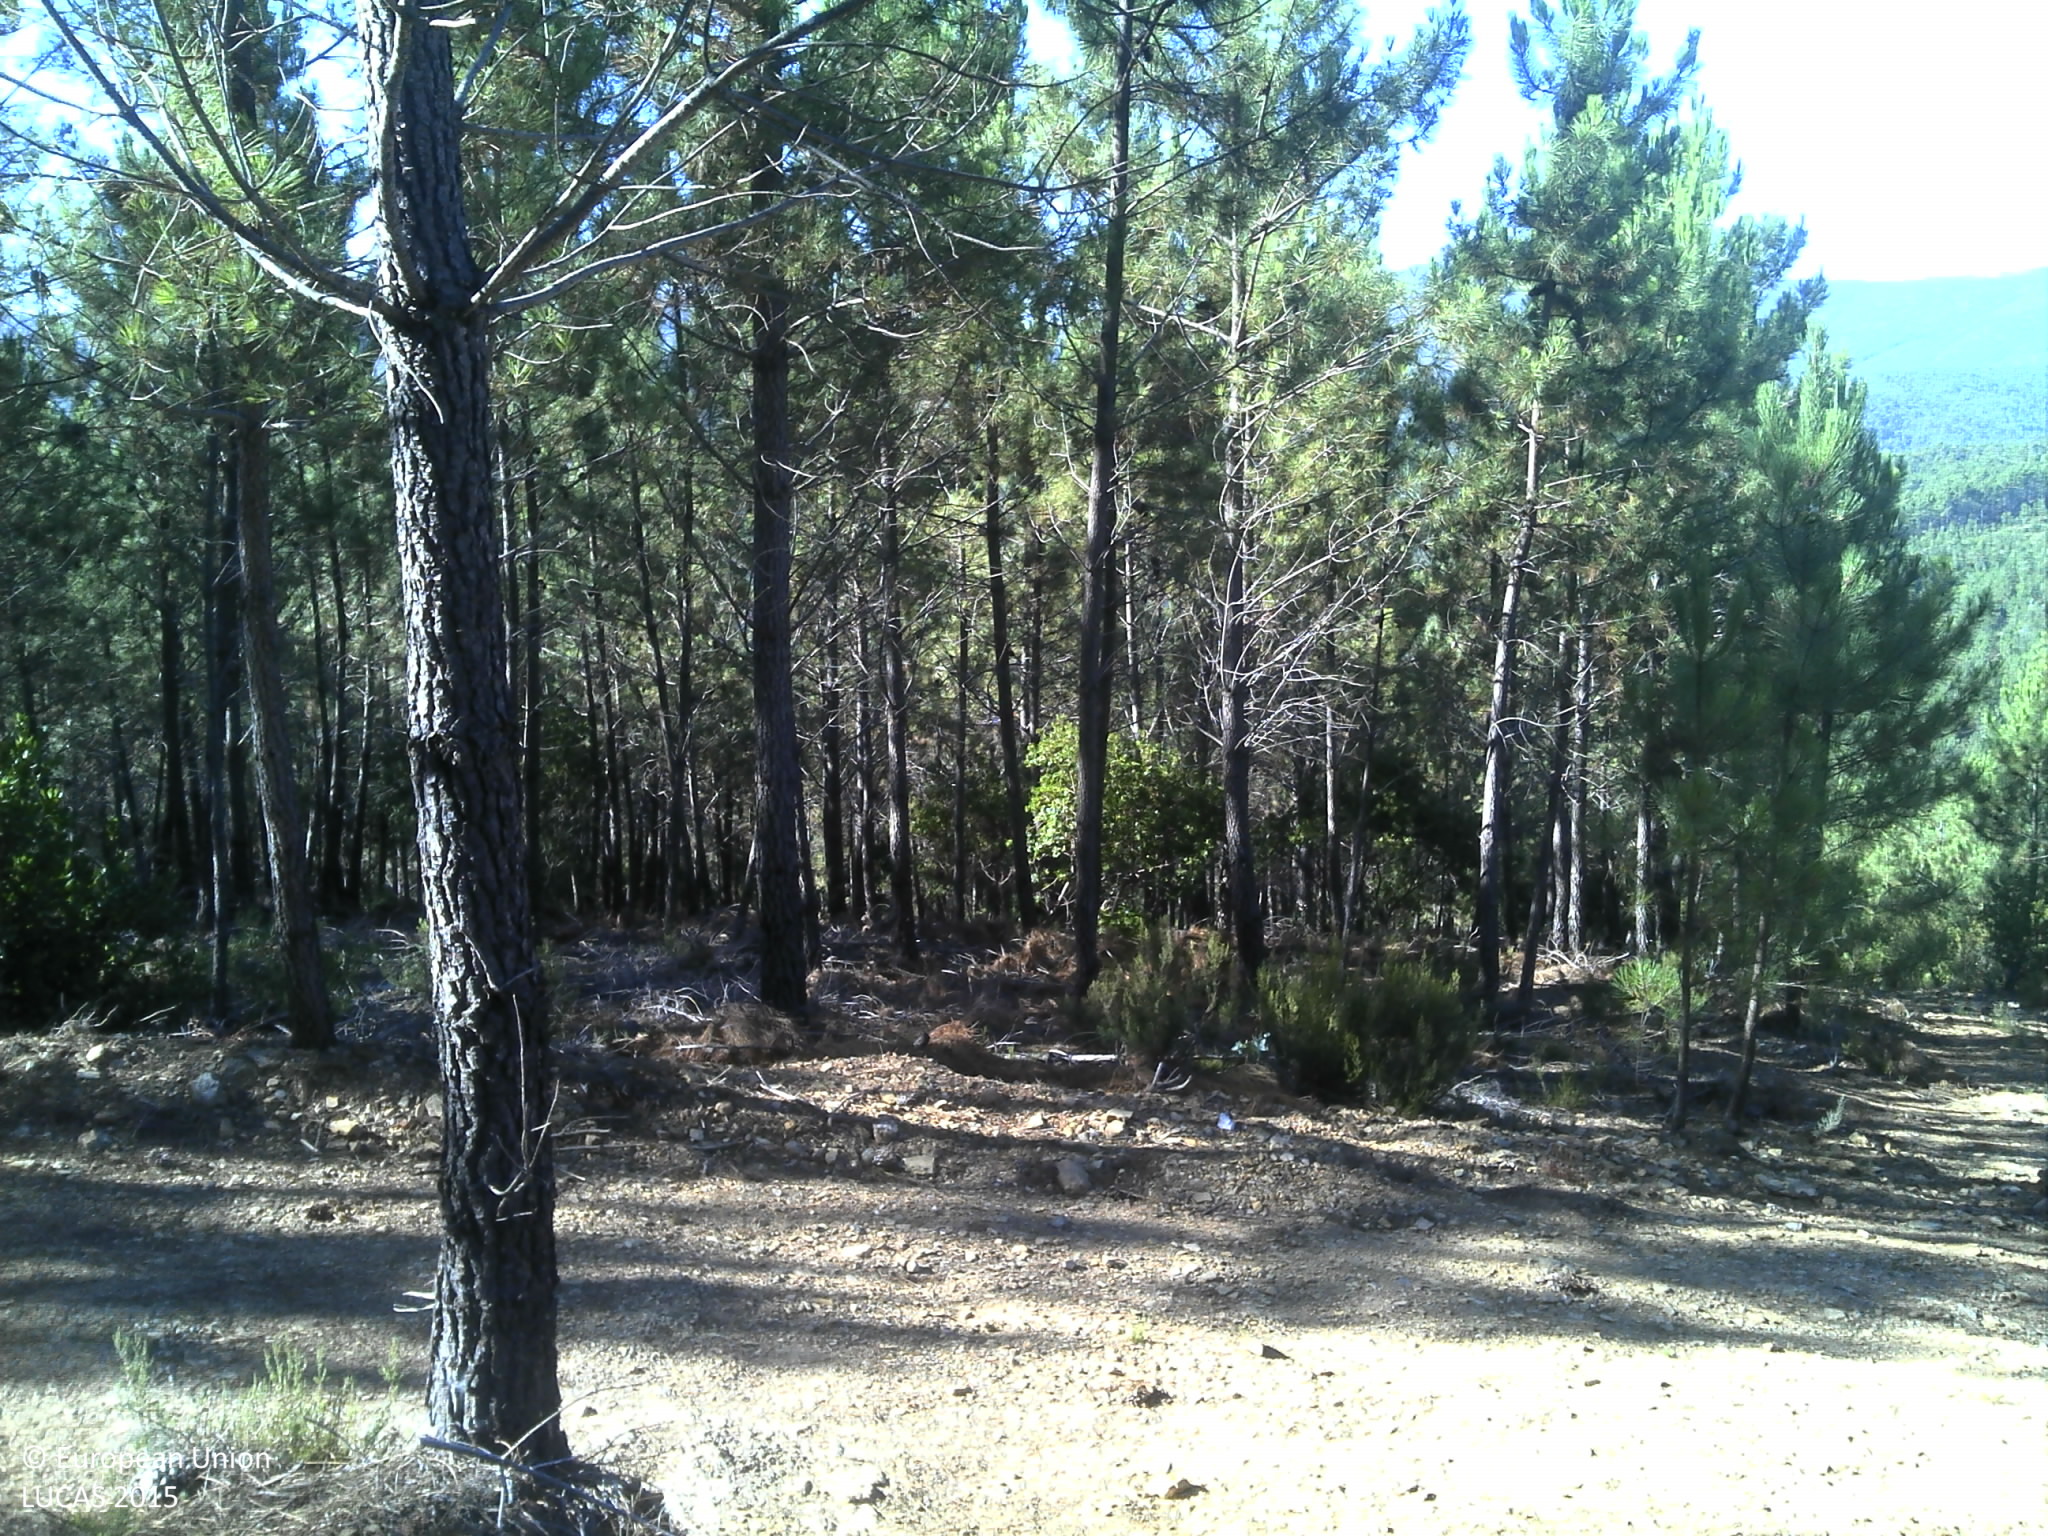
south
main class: Woodland
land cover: Pine dominated coniferous woodland
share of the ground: 50 - 75 %
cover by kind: coniferous forest trees 60 %, unconsolidated bare surface 30 %, shrubs 10 %
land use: Forestry
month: July
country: PT
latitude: 40.0859
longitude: -7.6888
